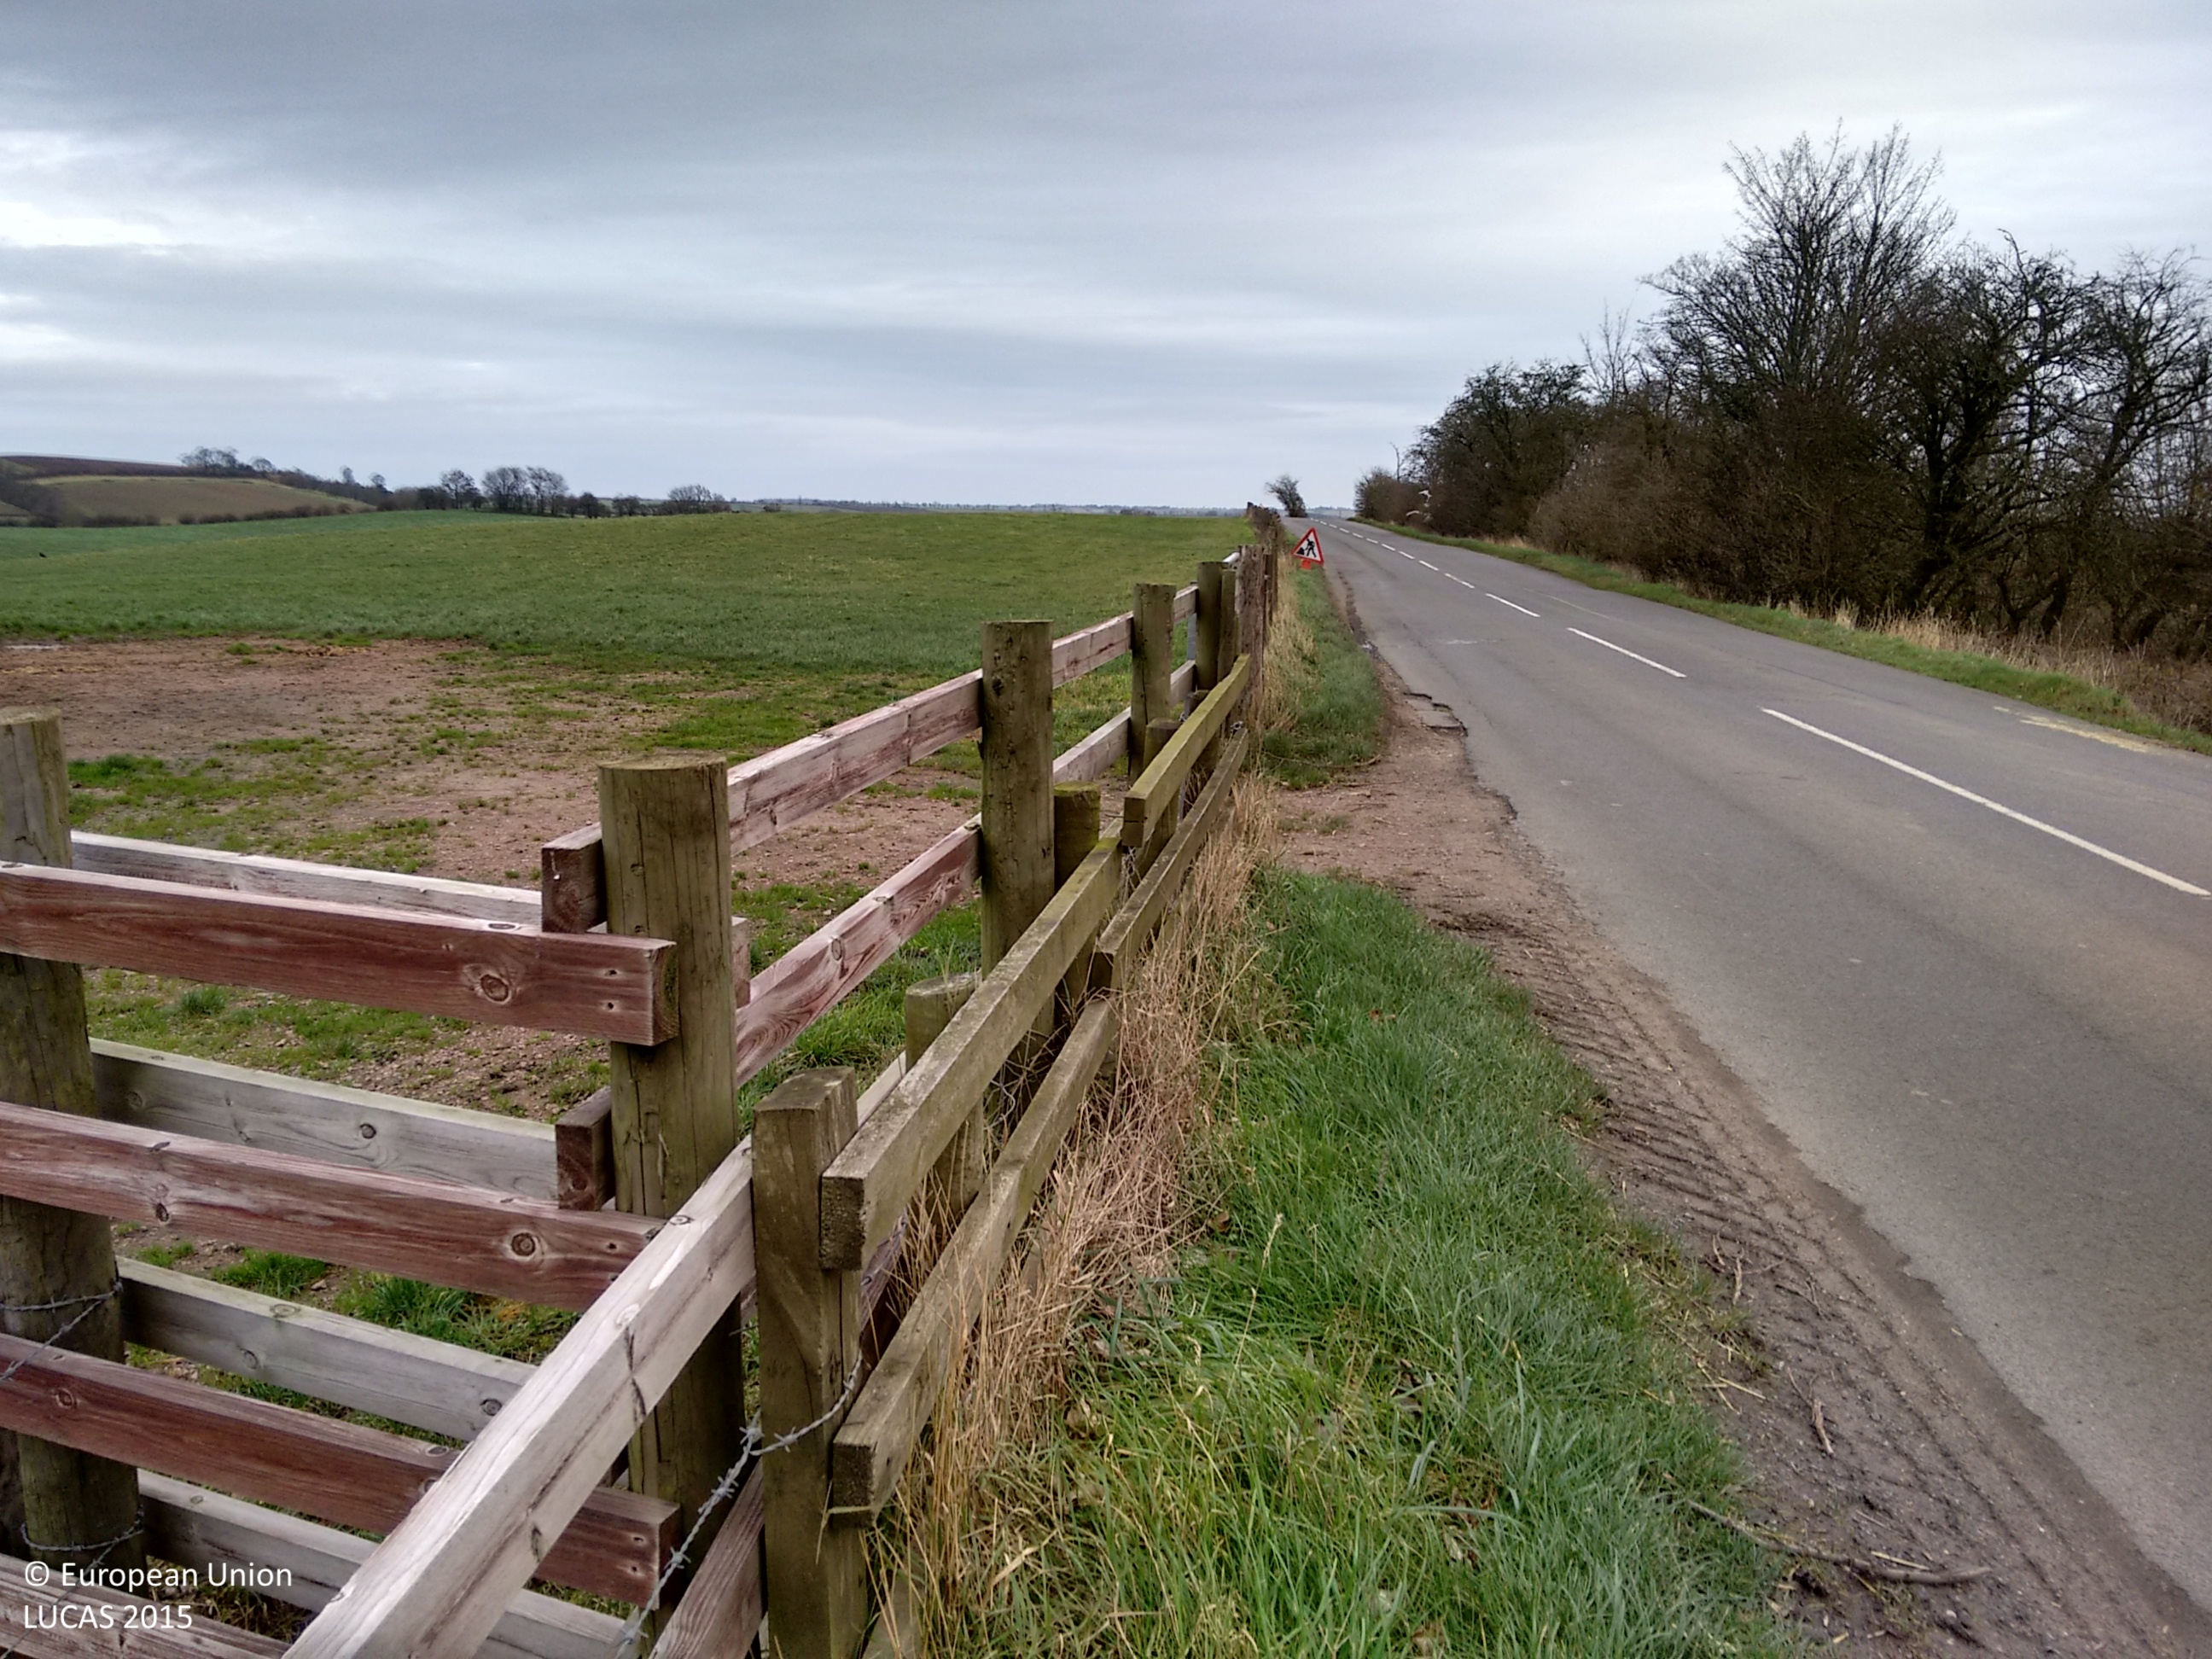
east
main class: Grassland
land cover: Grassland without tree/shrub cover
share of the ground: > 75 %
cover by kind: herbaceous plants 100 %
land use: Agriculture (excluding fallow land and kitchen gardens)
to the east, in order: Grassland without tree/shrub cover; Managed hedges
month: December
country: GB
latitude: 52.6820
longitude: -0.7953
